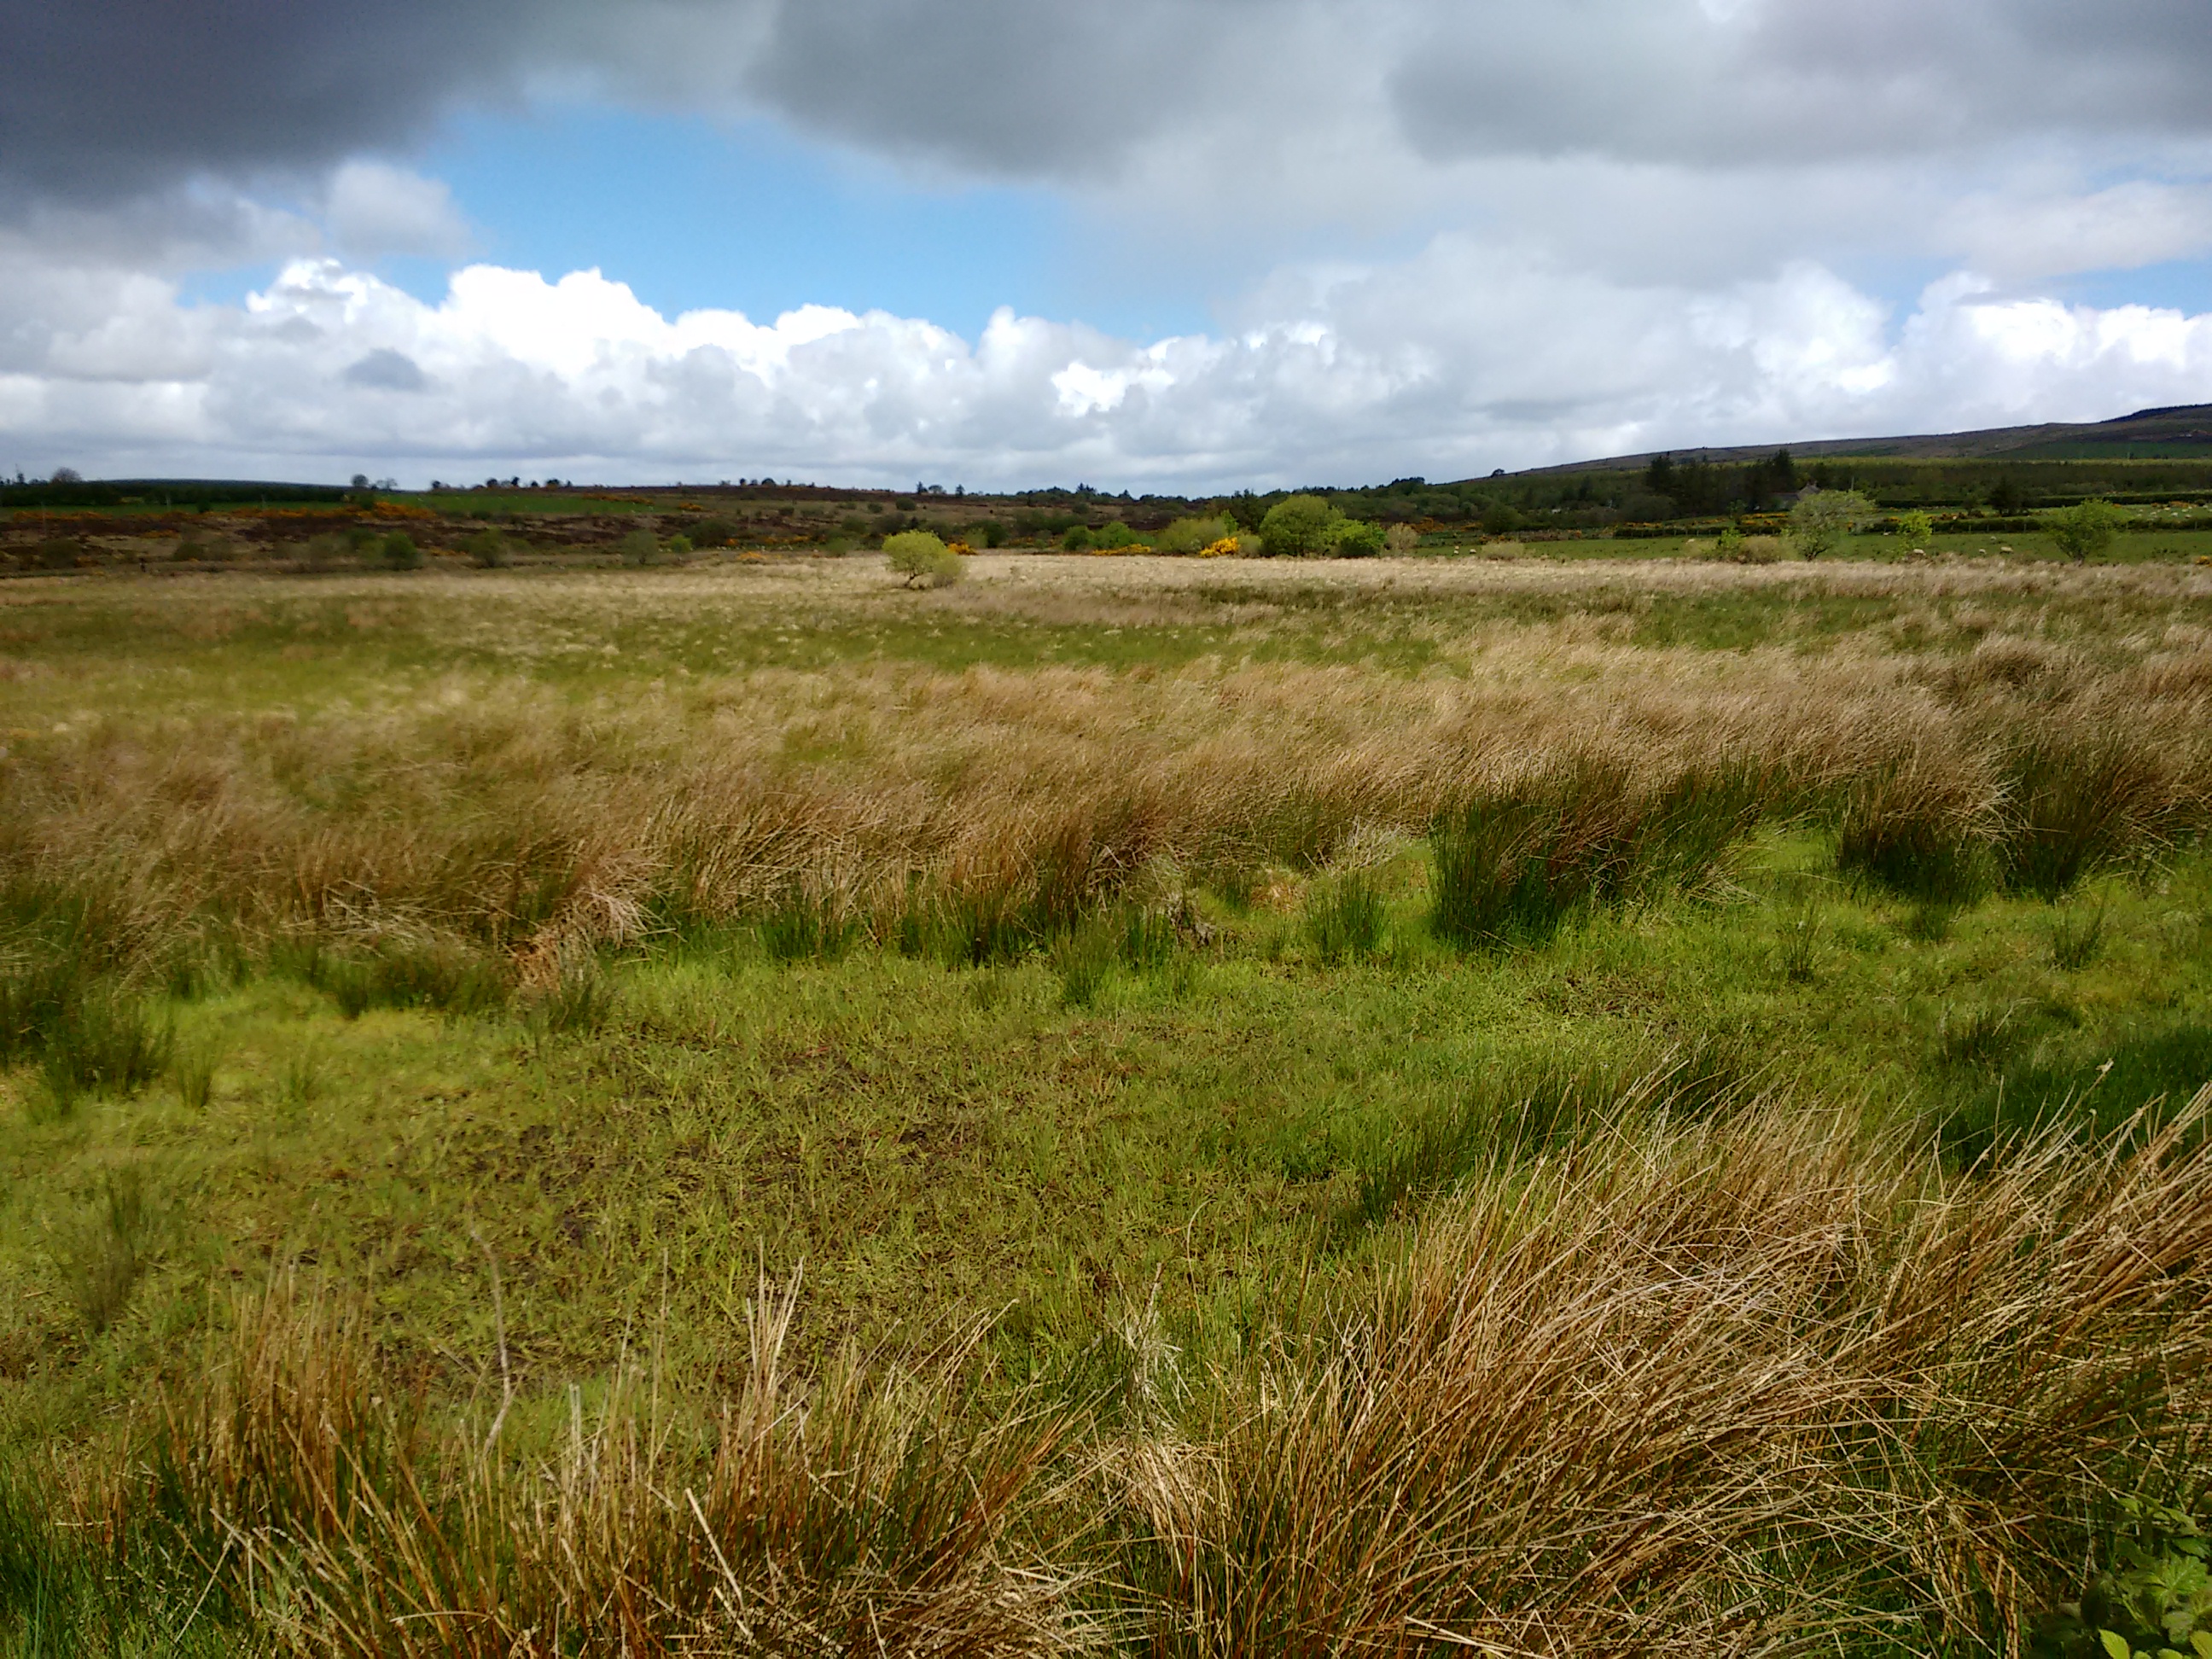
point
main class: Grassland
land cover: Grassland without tree/shrub cover
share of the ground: > 75 %
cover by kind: herbaceous plants 100 %
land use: Agriculture (excluding fallow land and kitchen gardens)
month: May
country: GB
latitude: 54.9683
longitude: -7.1215
